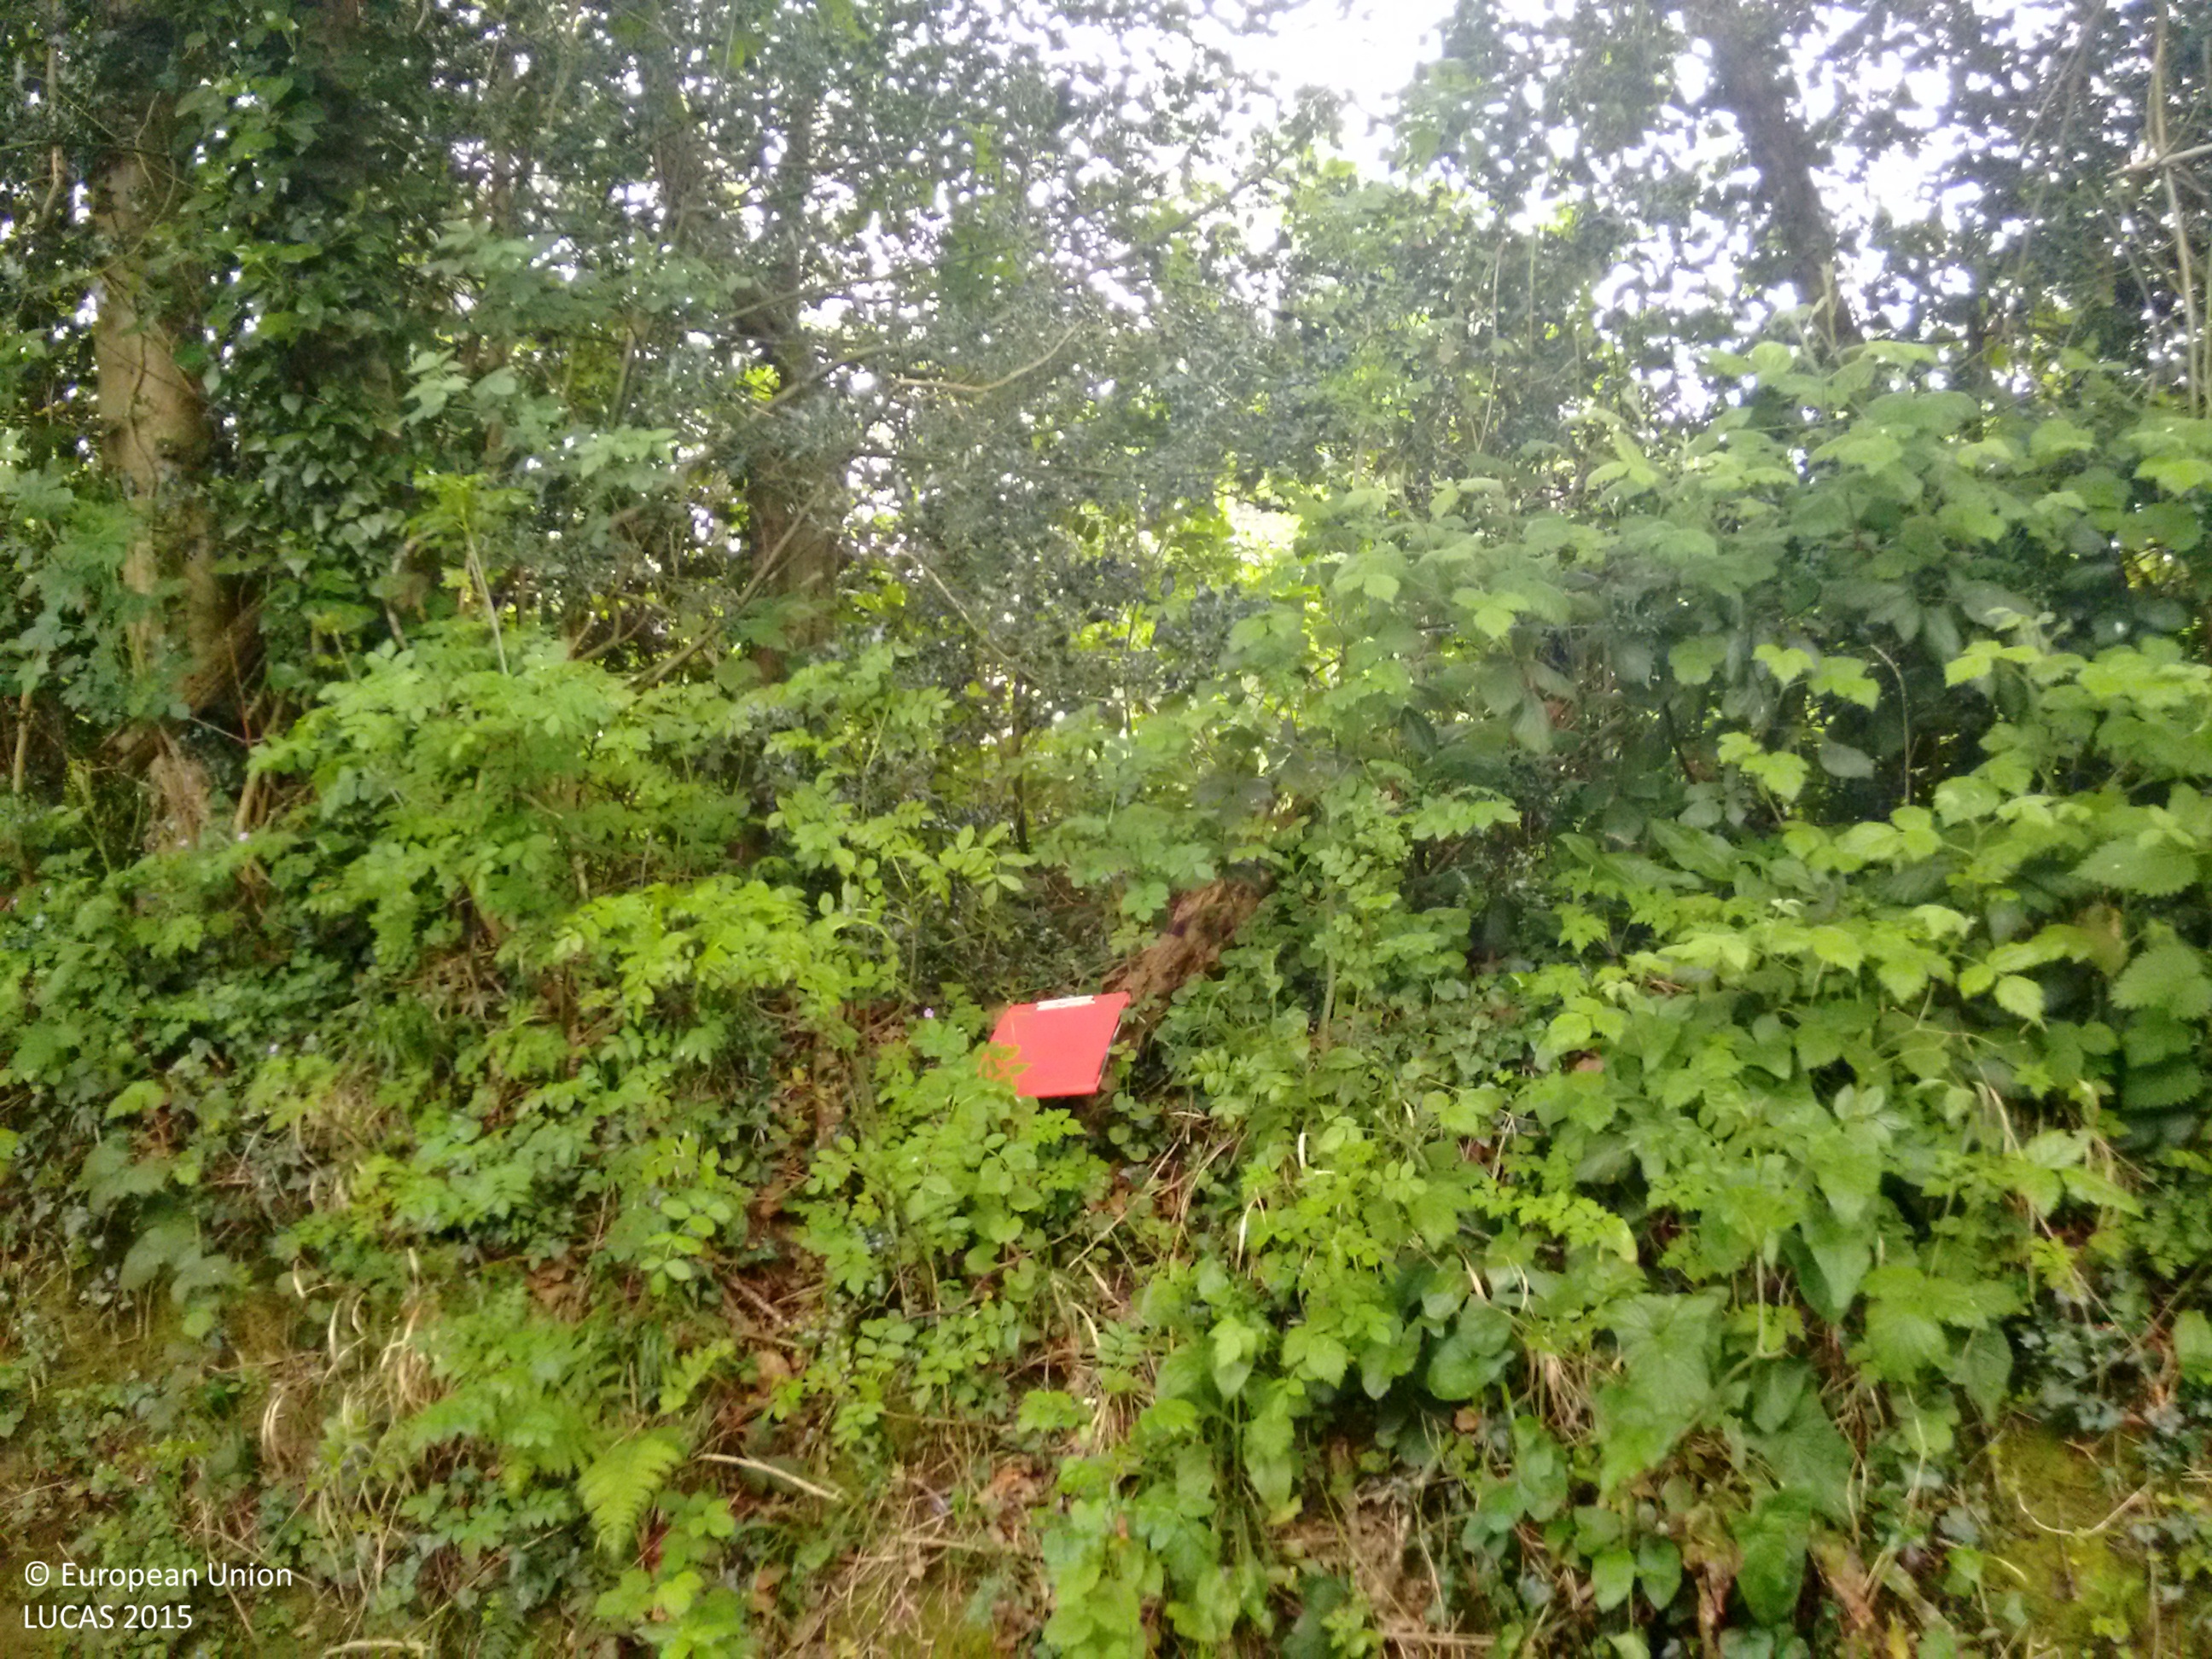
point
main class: Grassland
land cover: Grassland without tree/shrub cover
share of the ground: 50 - 75 %
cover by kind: herbaceous plants 75 %, unconsolidated bare surface 25 %
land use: Agriculture (excluding fallow land and kitchen gardens)
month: May
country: GB
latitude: 51.0772
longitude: -2.3244
